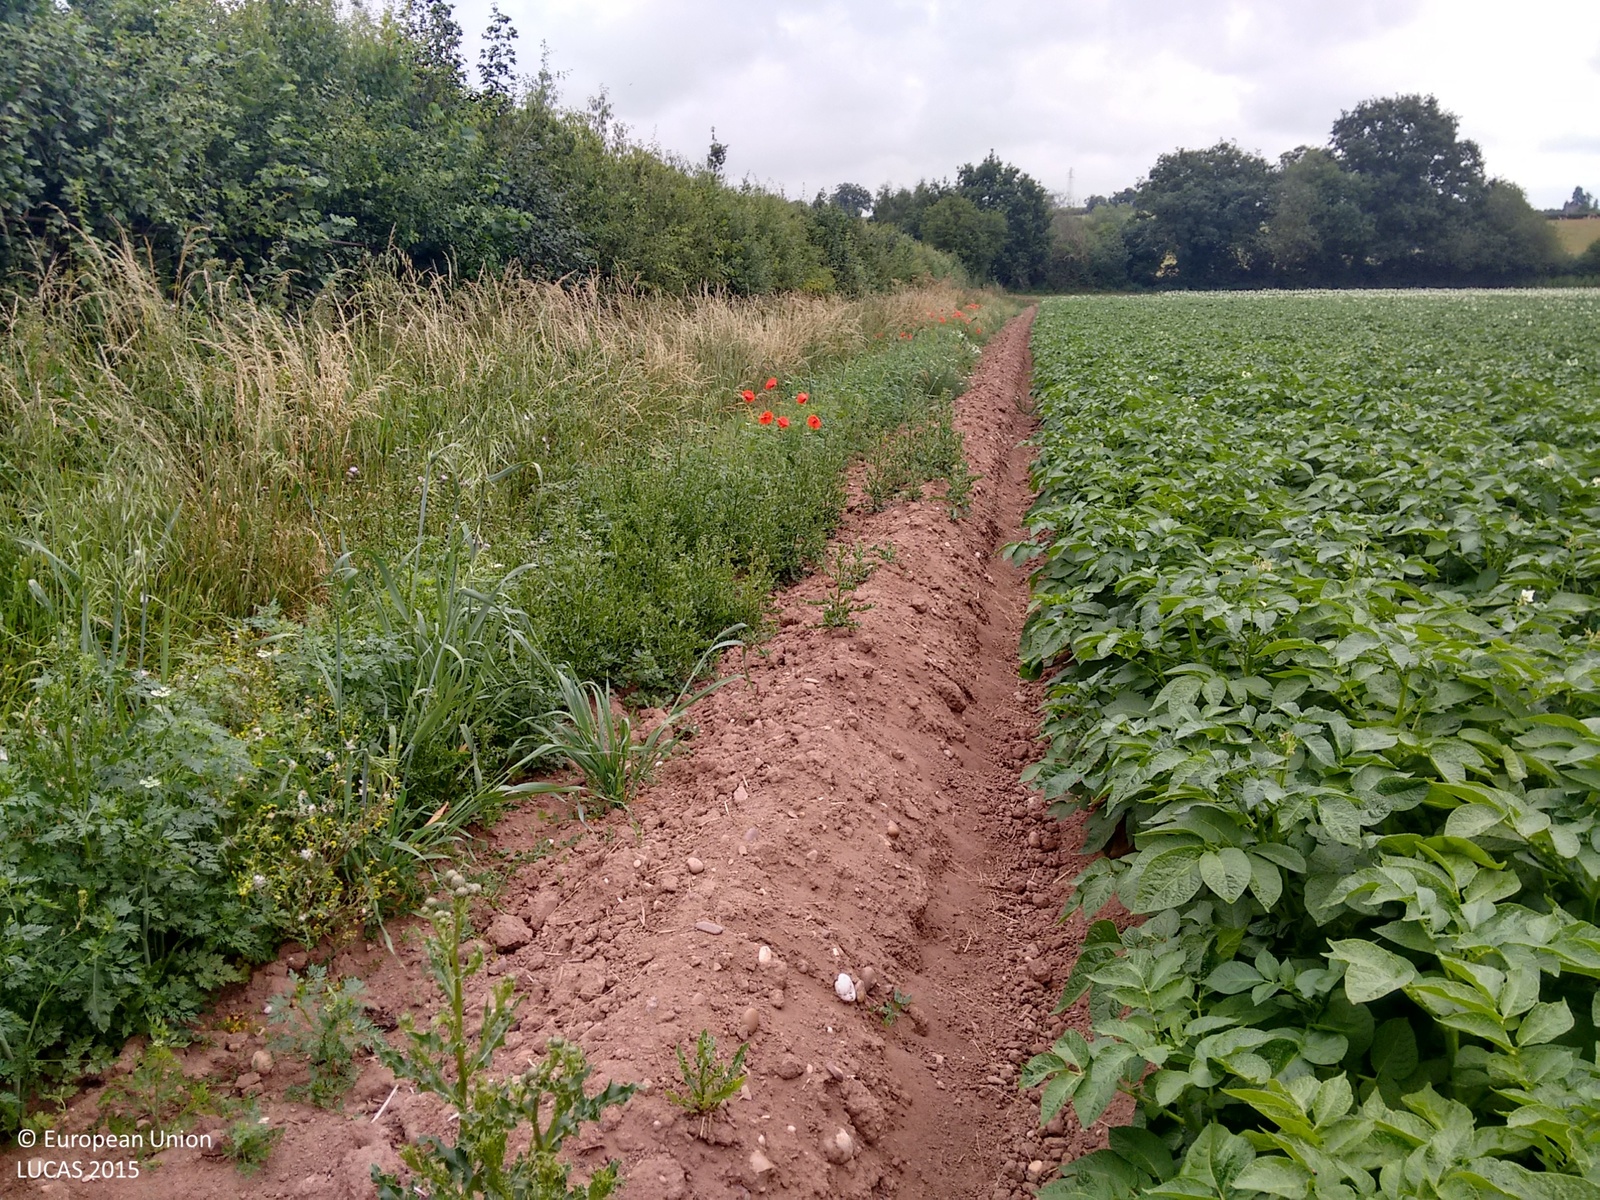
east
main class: Cropland
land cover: Potatoes
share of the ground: > 75 %
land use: Agriculture (excluding fallow land and kitchen gardens)
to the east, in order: Potatoes; Grass margins; Fences; Abandoned hedges; Fences; Grassland without tree/shrub cover; Fences; Broadleaved woodland; Rivers and streams; Grassland without tree/shrub cover
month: July
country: GB
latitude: 52.2334
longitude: -2.2297
